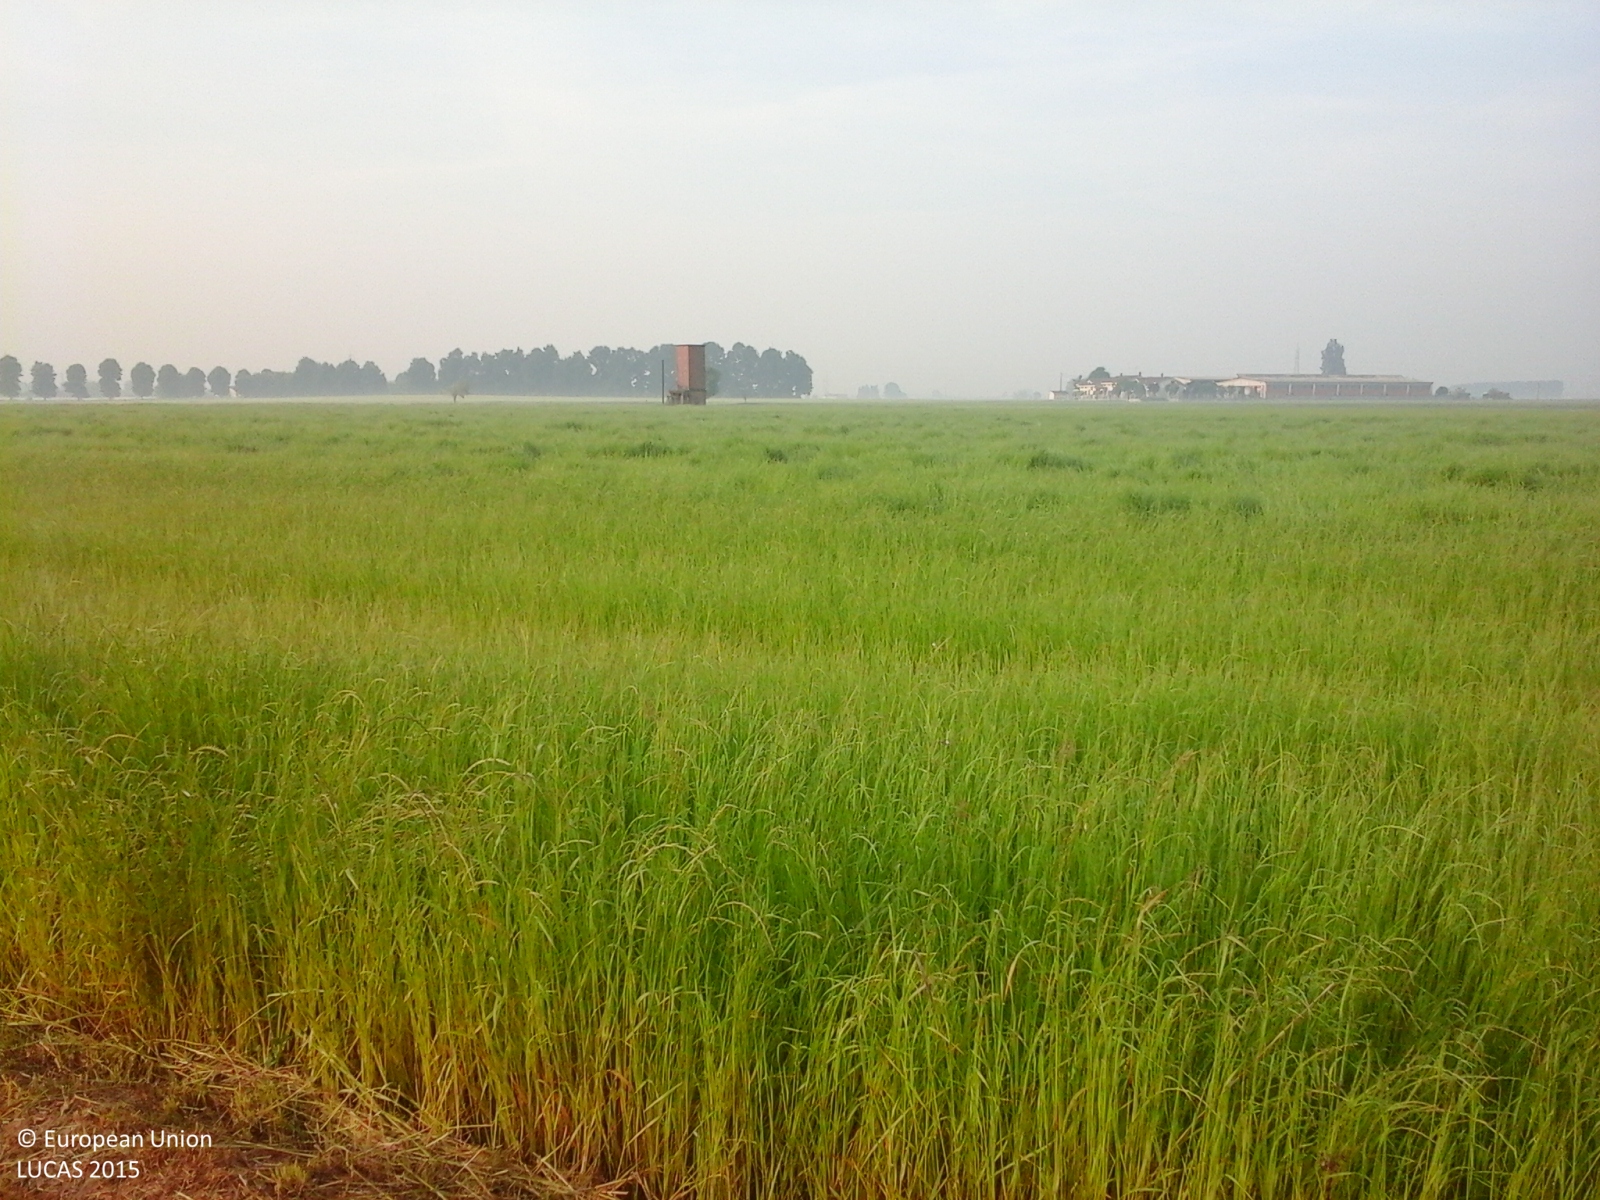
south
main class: Cropland
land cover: Temporary grasslands
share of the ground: > 75 %
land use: Agriculture (excluding fallow land and kitchen gardens)
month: May
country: IT
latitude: 44.9031
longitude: 7.7372
